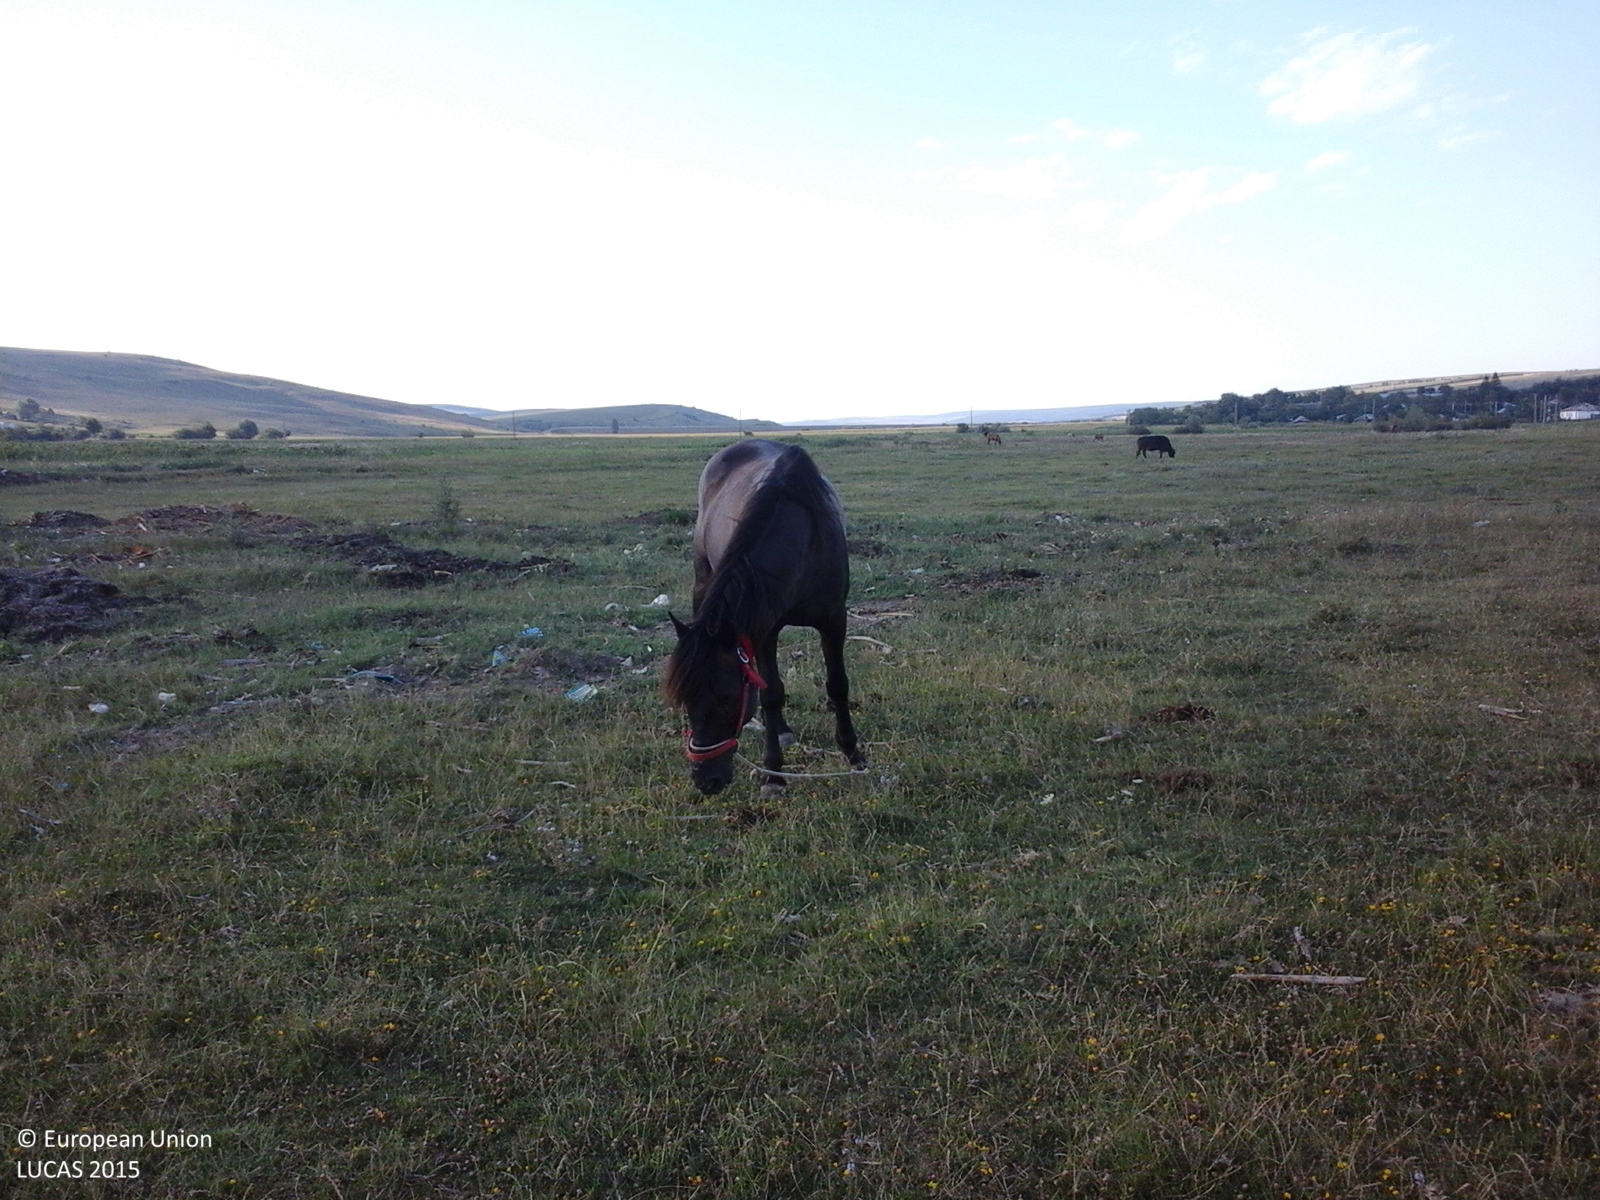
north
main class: Grassland
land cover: Grassland without tree/shrub cover
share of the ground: > 75 %
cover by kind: herbaceous plants 100 %
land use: Agriculture (excluding fallow land and kitchen gardens)
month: July
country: RO
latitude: 46.2647
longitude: 27.5613
